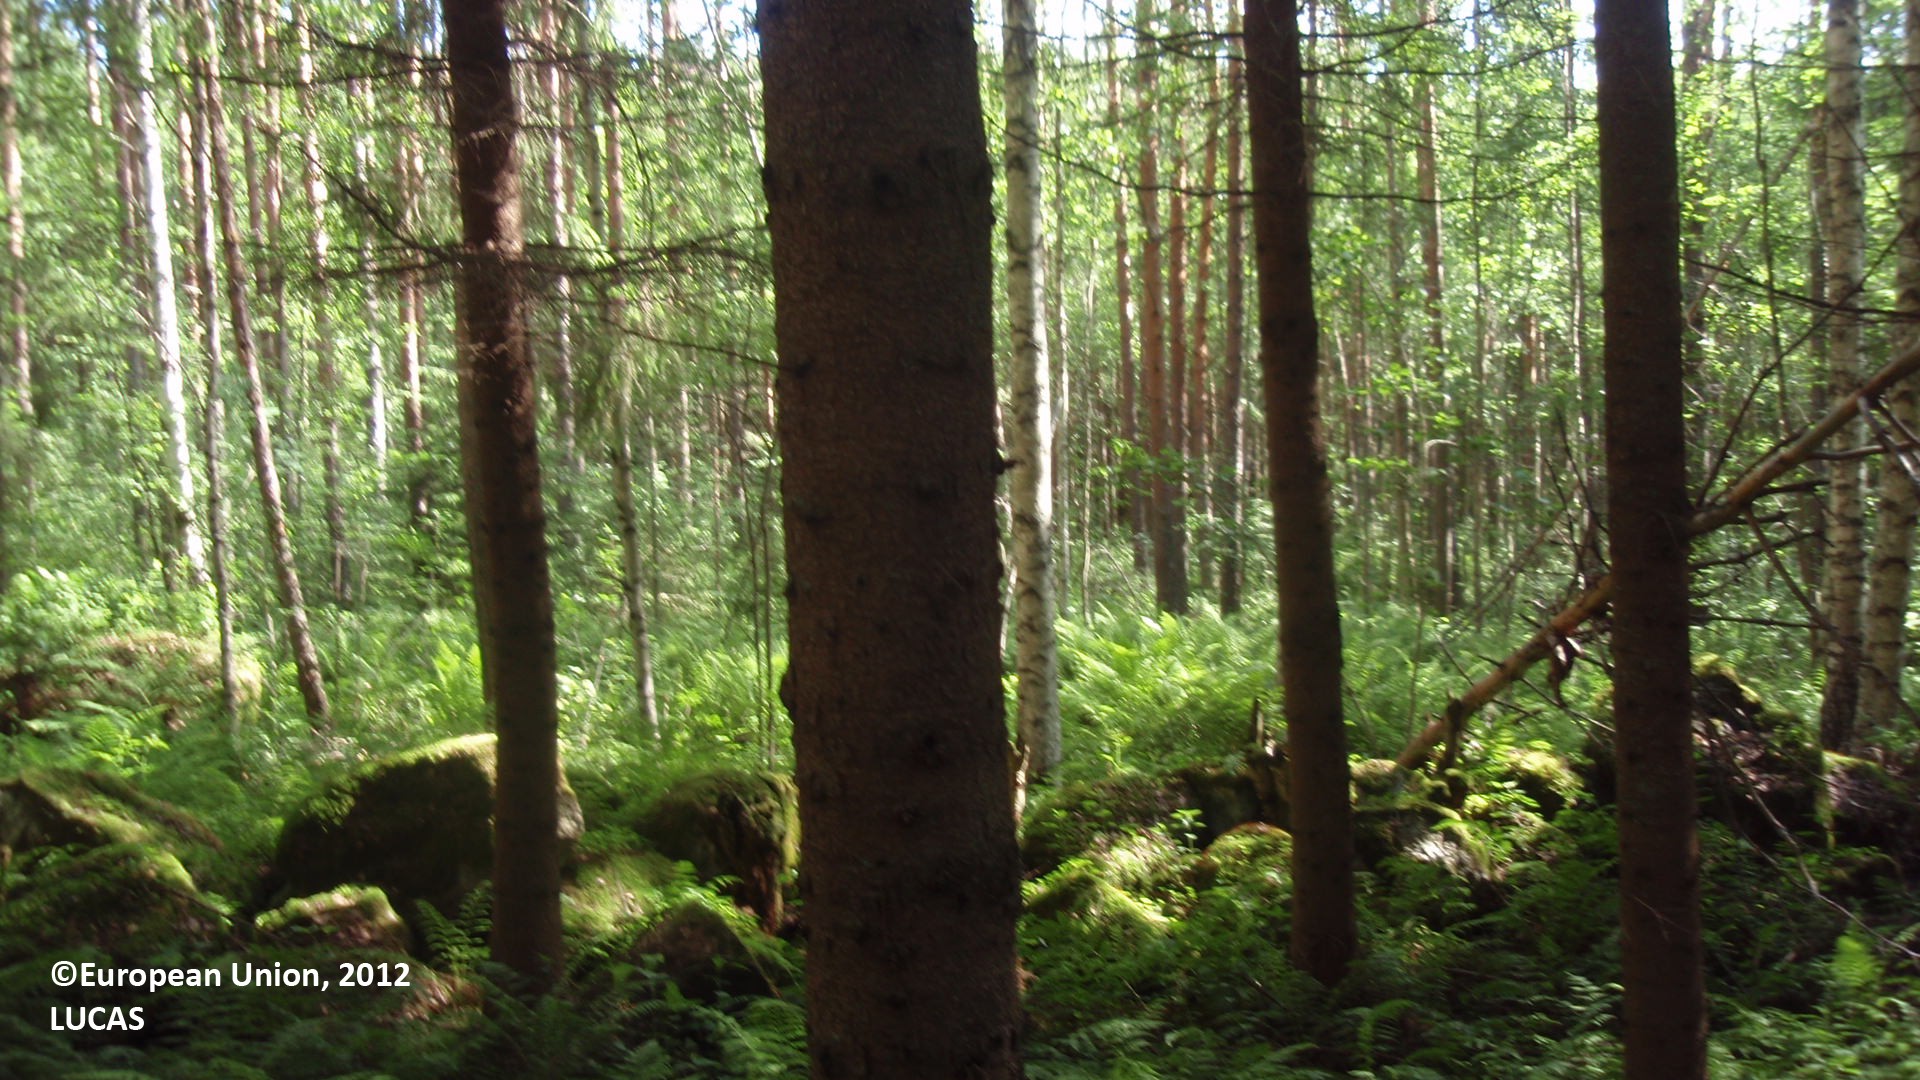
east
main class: Woodland
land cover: Spruce dominated mixed woodland
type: boreal forest
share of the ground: 25 - 50 %
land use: Forestry
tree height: > 5 m
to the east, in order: Spruce dominated mixed woodland; Dry stone walls; Pine dominated coniferous woodland; Spruce dominated coniferous woodland; Artificial constructions in urban areas; Grass margins; Paved roads, cycling and walking lanes; Managed hedges; Broadleaved woodland
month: July
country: FI
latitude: 61.7120
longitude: 28.1872
